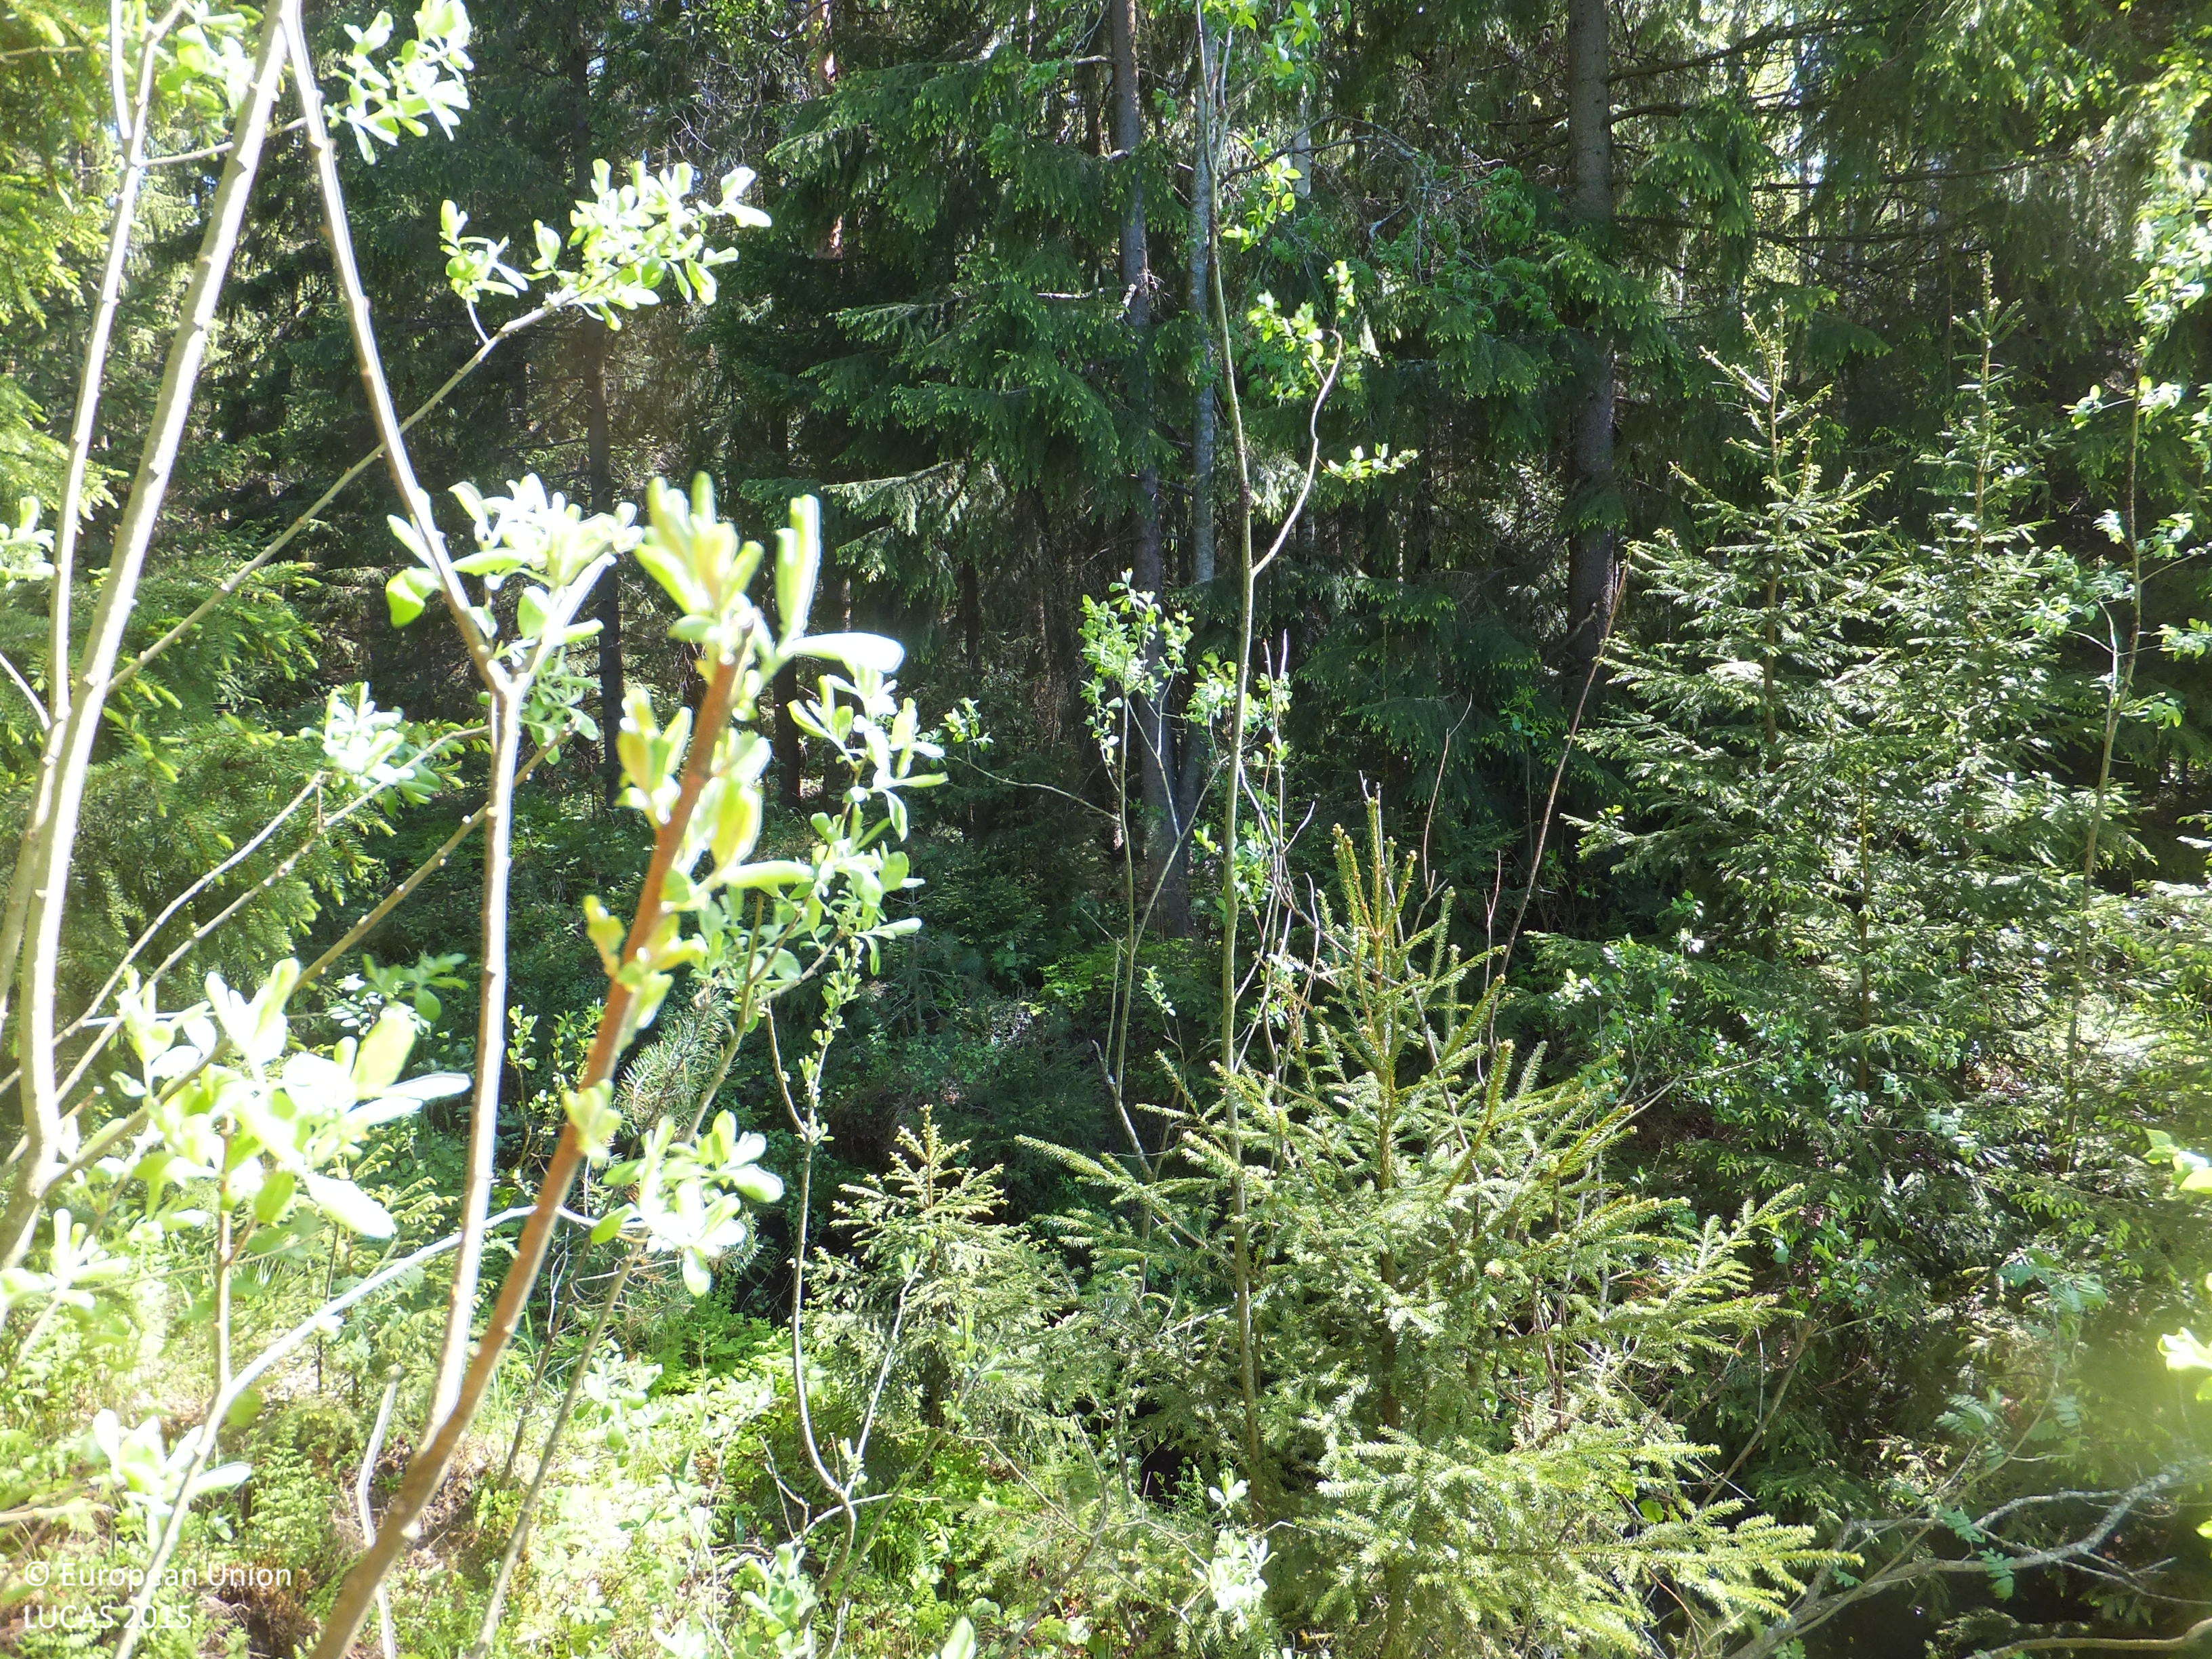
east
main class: Woodland
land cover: Spruce dominated mixed woodland
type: boreal forest
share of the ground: 50 - 75 %
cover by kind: coniferous forest trees 30 %, broadleaved forest trees 30 %, shrubs 20 %, herbaceous plants 10 %, lichens and mosses 10 %
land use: Forestry
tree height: > 5 m
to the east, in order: Spruce dominated mixed woodland; Ditches and canals; Spruce dominated mixed woodland; Spruce dominated coniferous woodland
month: June
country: FI
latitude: 63.6445
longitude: 22.9535
